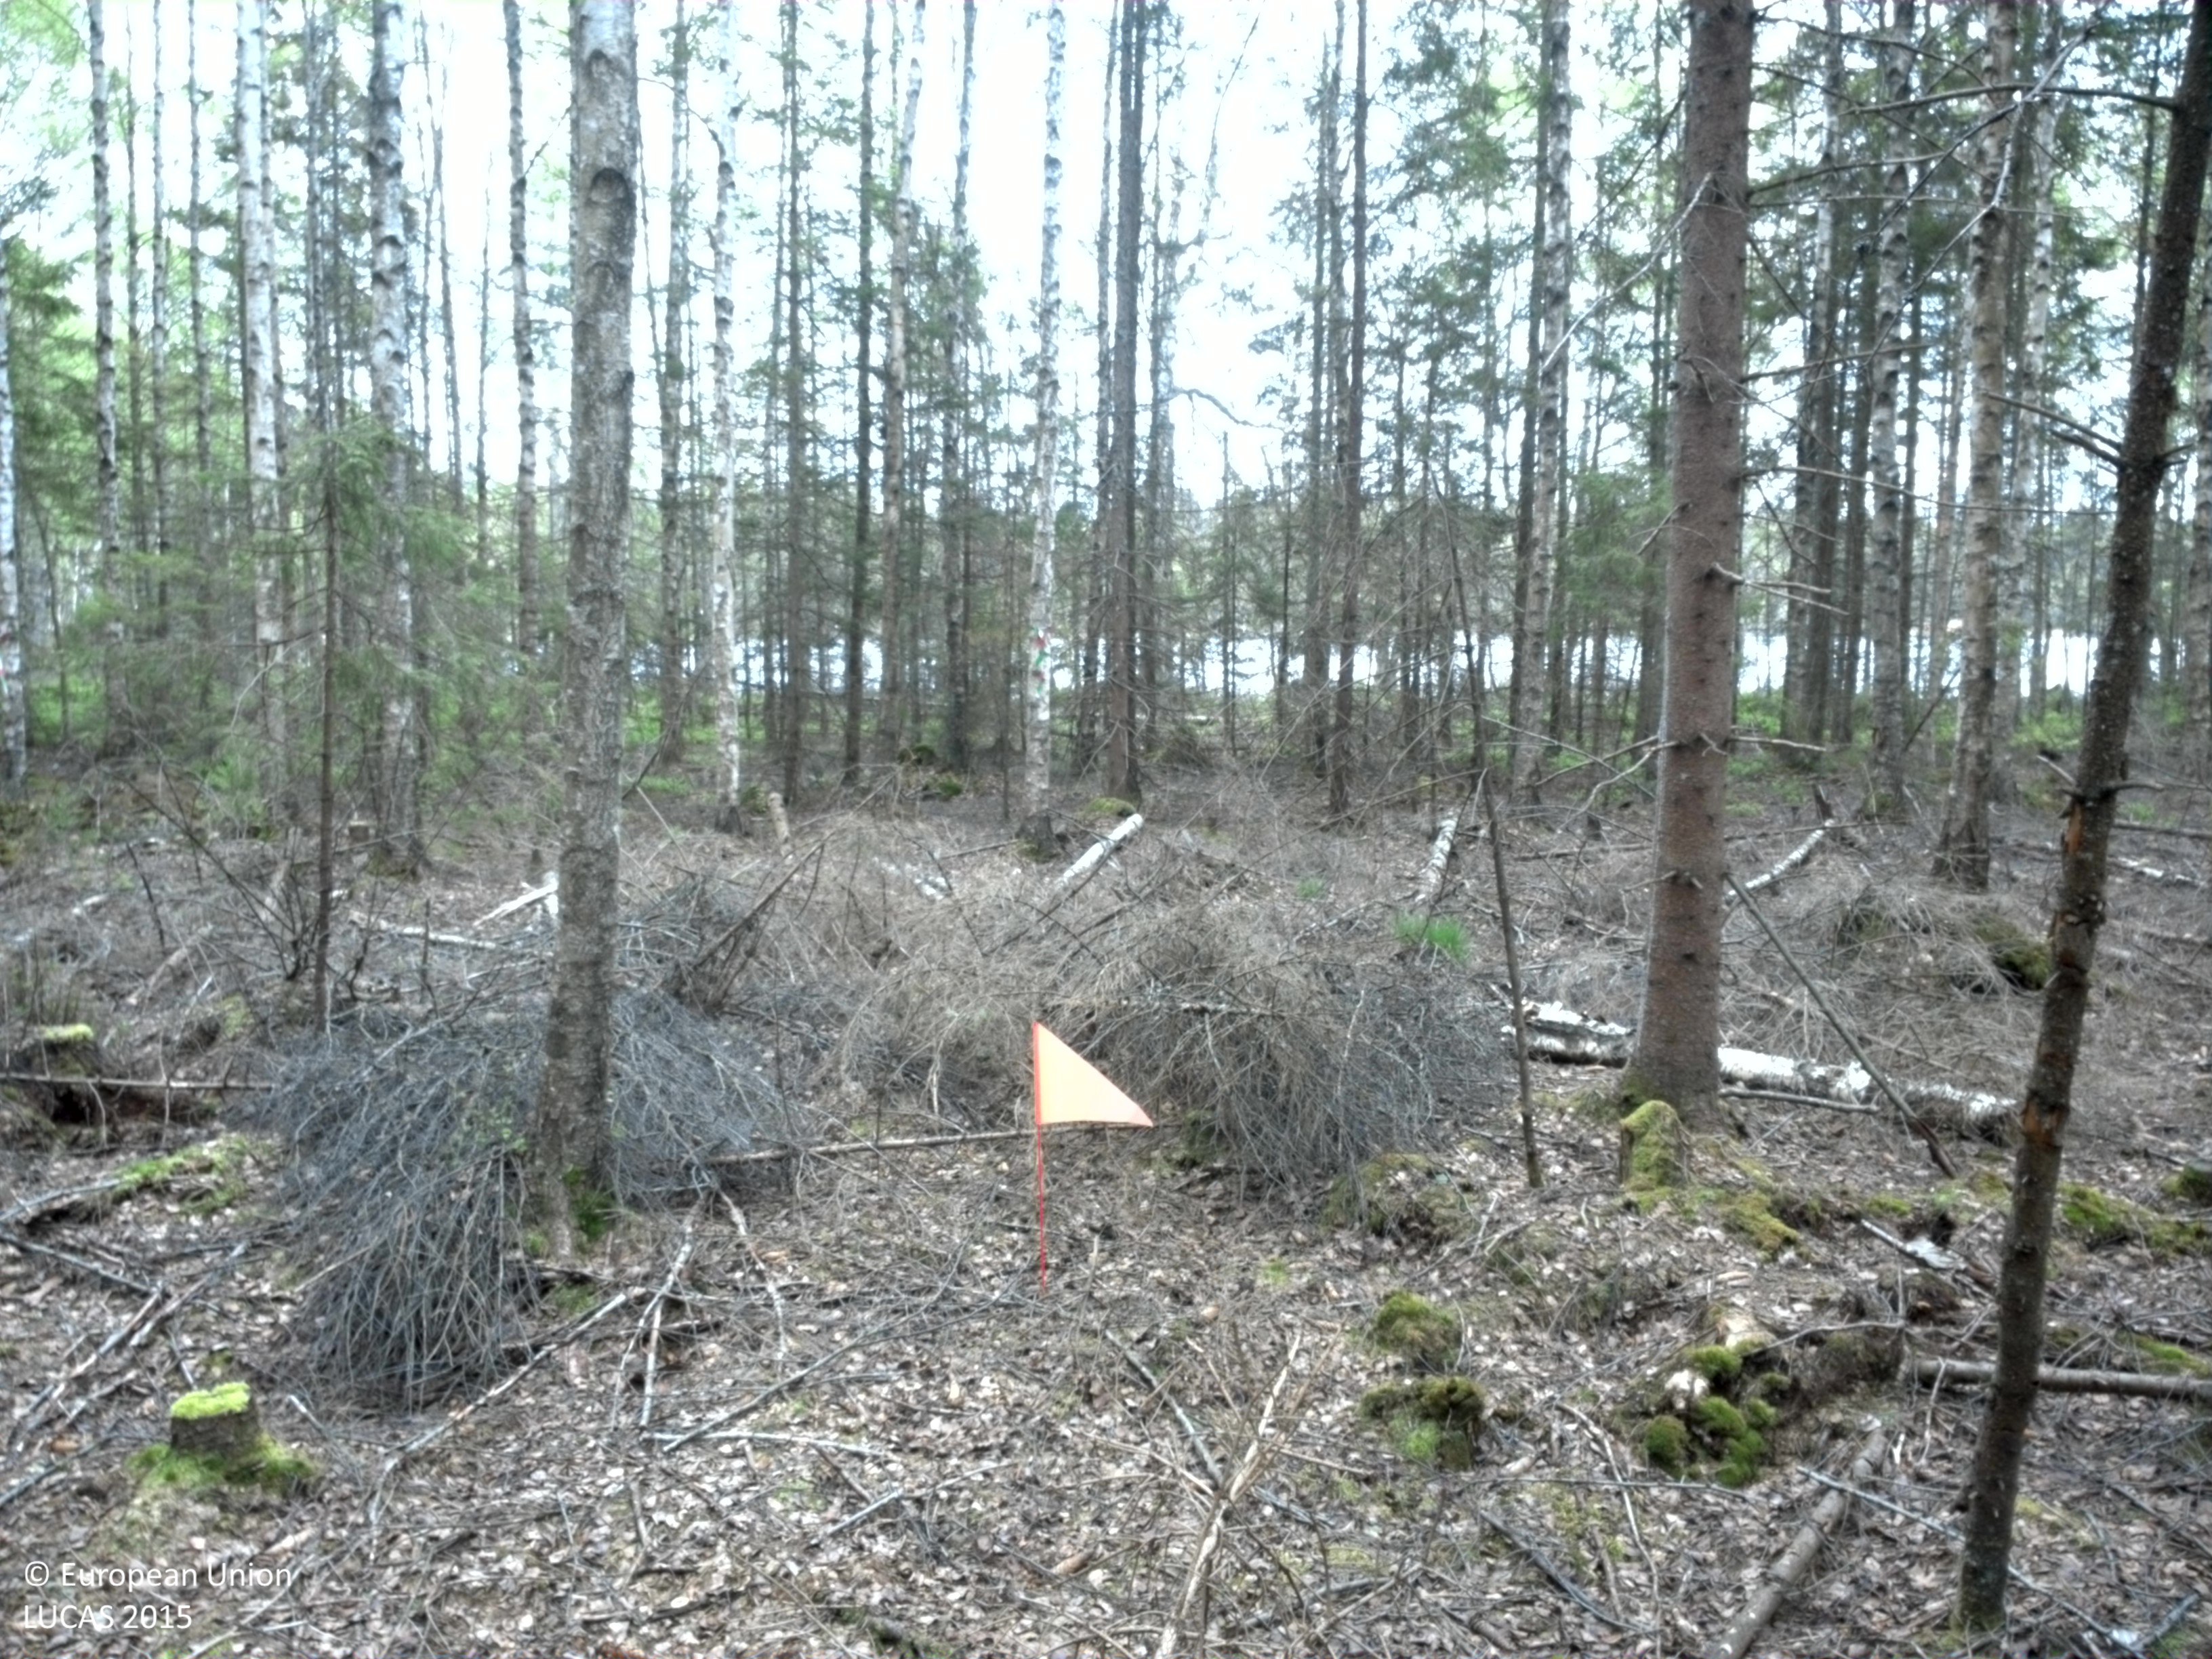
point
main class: Woodland
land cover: Spruce dominated mixed woodland
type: boreal forest
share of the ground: 50 - 75 %
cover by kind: coniferous forest trees 30 %, broadleaved forest trees 30 %, lichens and mosses 30 %, shrubs 10 %
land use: Forestry
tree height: > 5 m
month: May
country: SE
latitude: 56.8548
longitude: 15.2619
